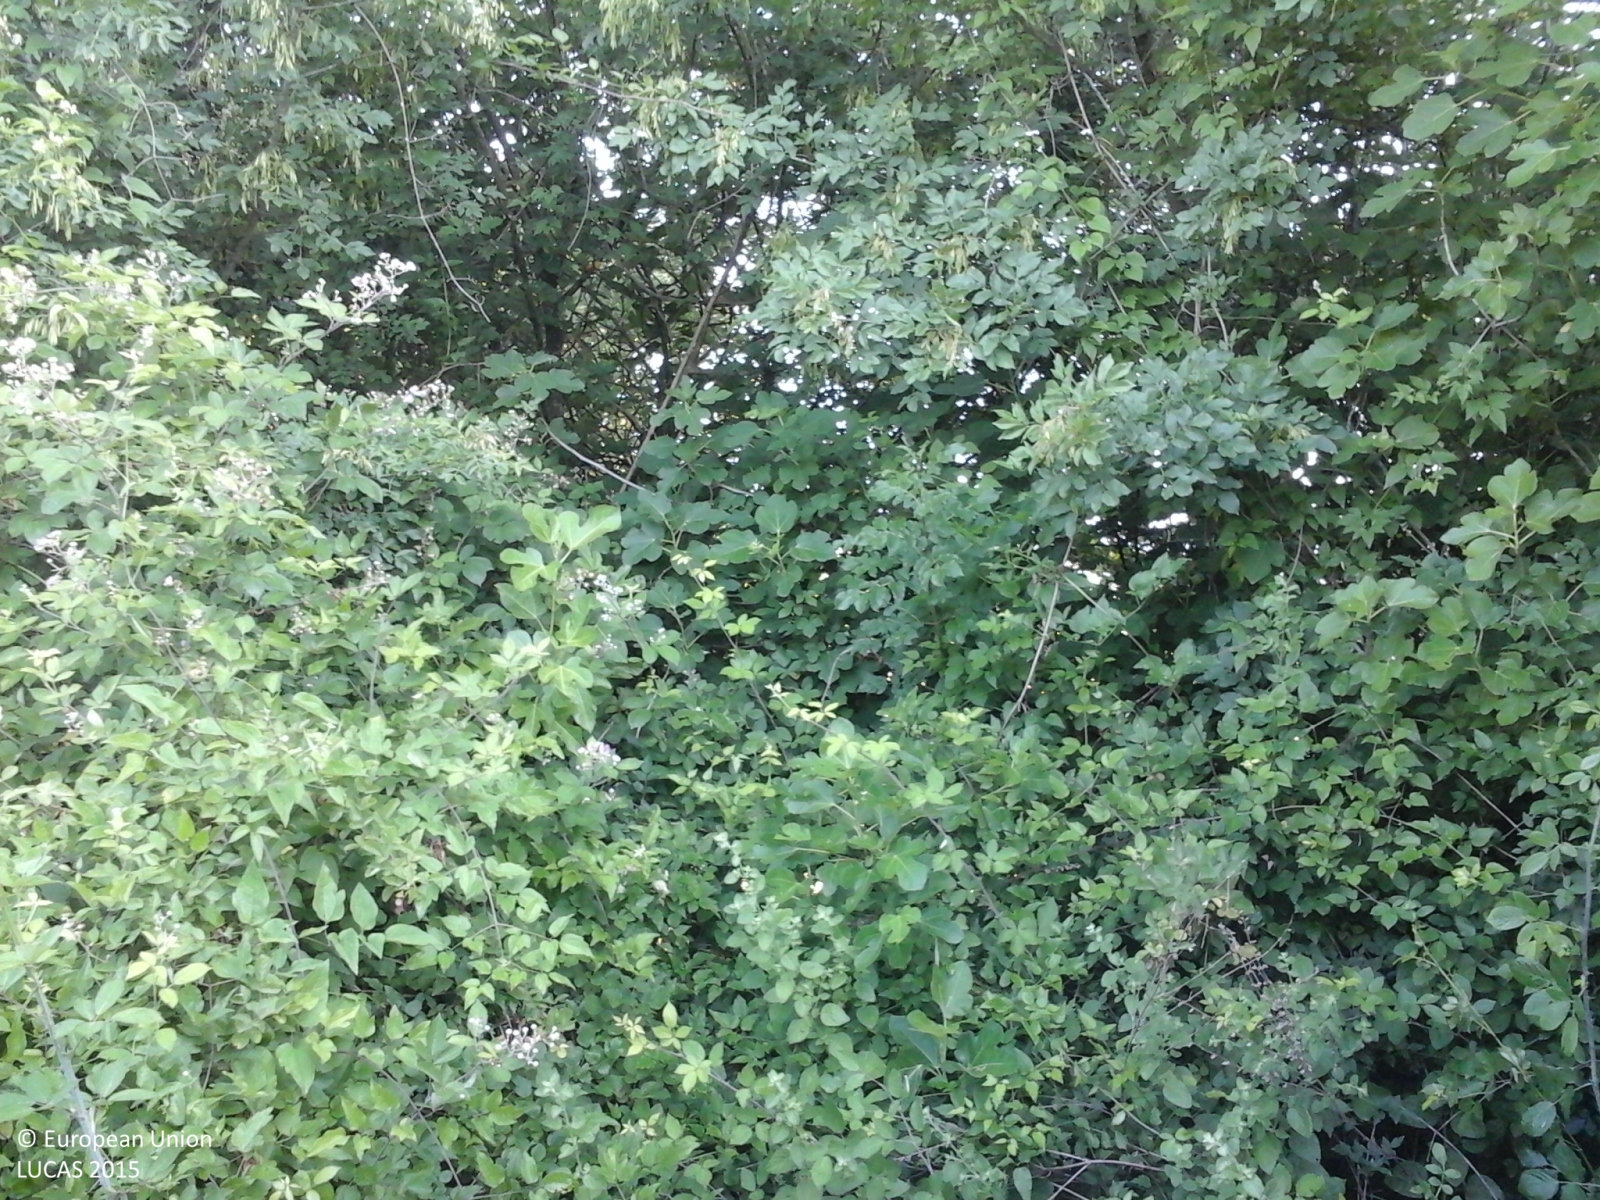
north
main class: Woodland
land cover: Broadleaved woodland
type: thermophilous deciduous forest
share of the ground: > 75 %
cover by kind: shrubs 70 %, broadleaved forest trees 15 %, herbaceous plants 15 %
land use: Abandoned areas
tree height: < 5 m
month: June
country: IT
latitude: 41.6202
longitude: 13.4076
